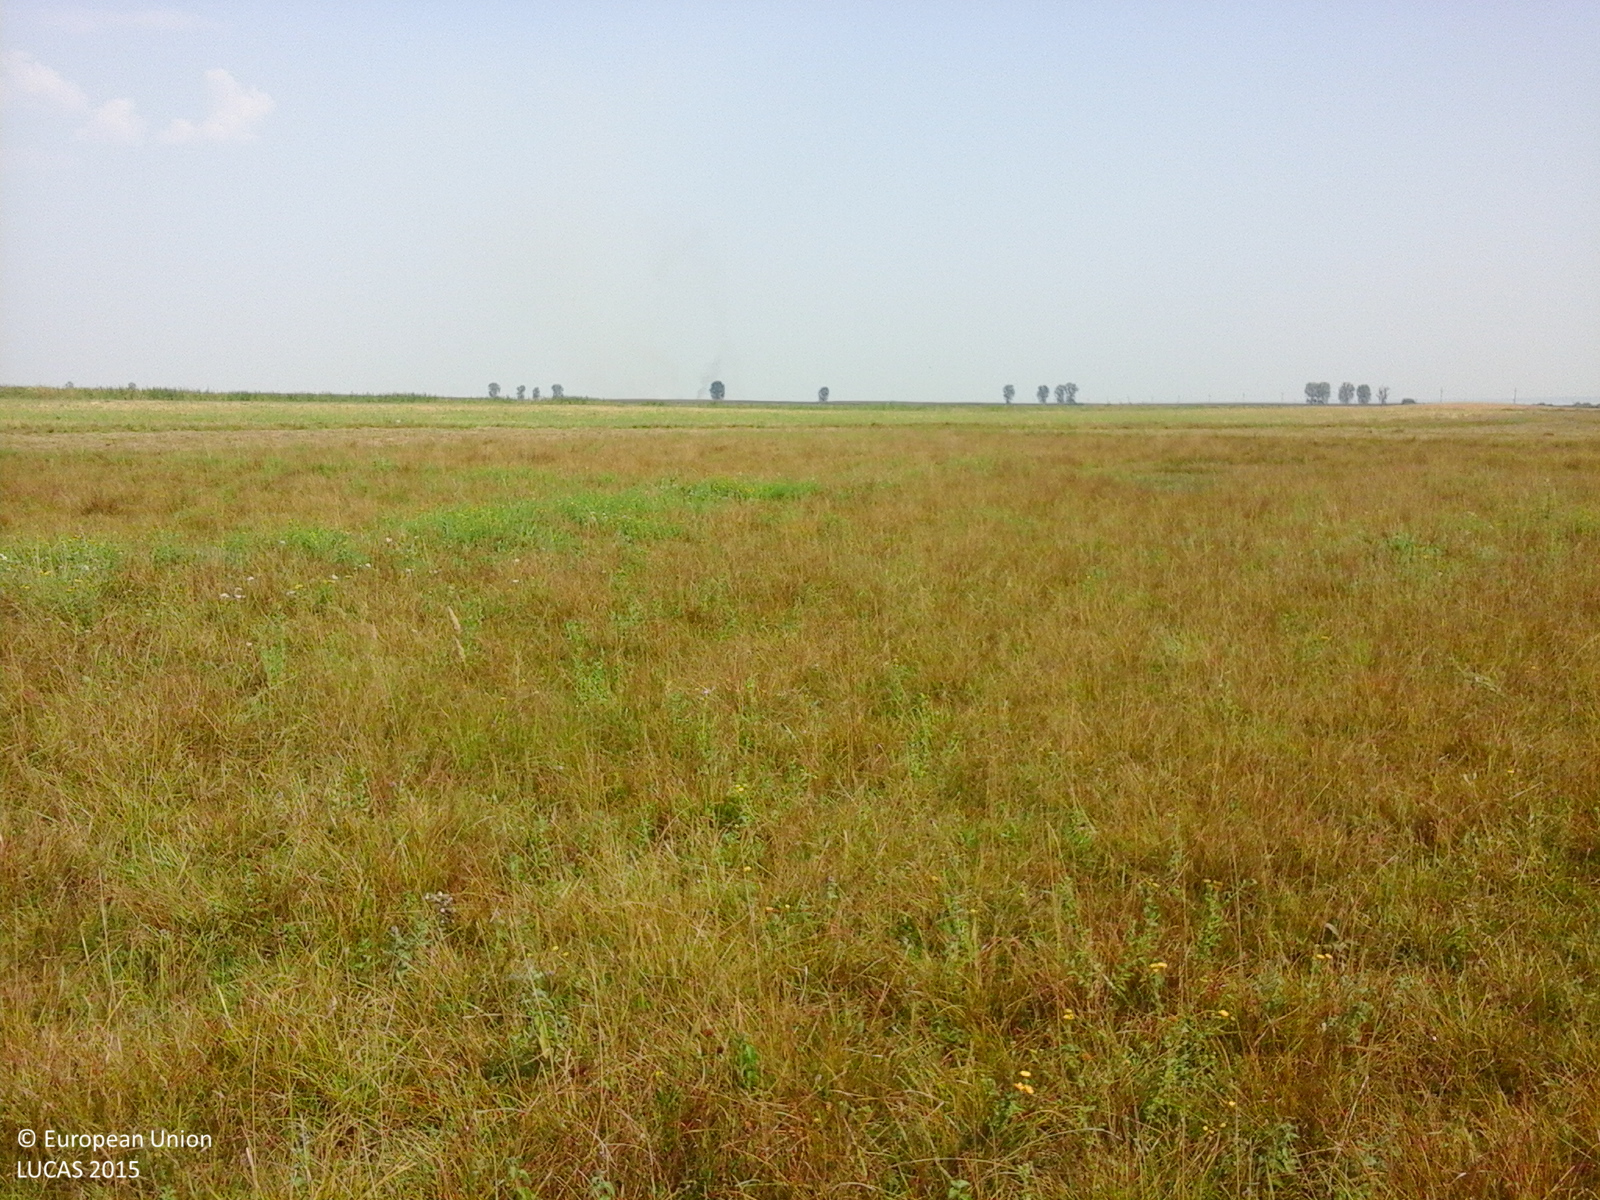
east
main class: Grassland
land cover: Grassland without tree/shrub cover
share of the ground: > 75 %
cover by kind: herbaceous plants 100 %
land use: Agriculture (excluding fallow land and kitchen gardens)
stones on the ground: < 10 %
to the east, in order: Grassland without tree/shrub cover; Tracks; Grassland without tree/shrub cover; Ditches and canals; Tracks; Sunflower; Tracks; Ditches and canals; Grassland without tree/shrub cover
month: August
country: RO
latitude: 43.9074
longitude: 23.1797
